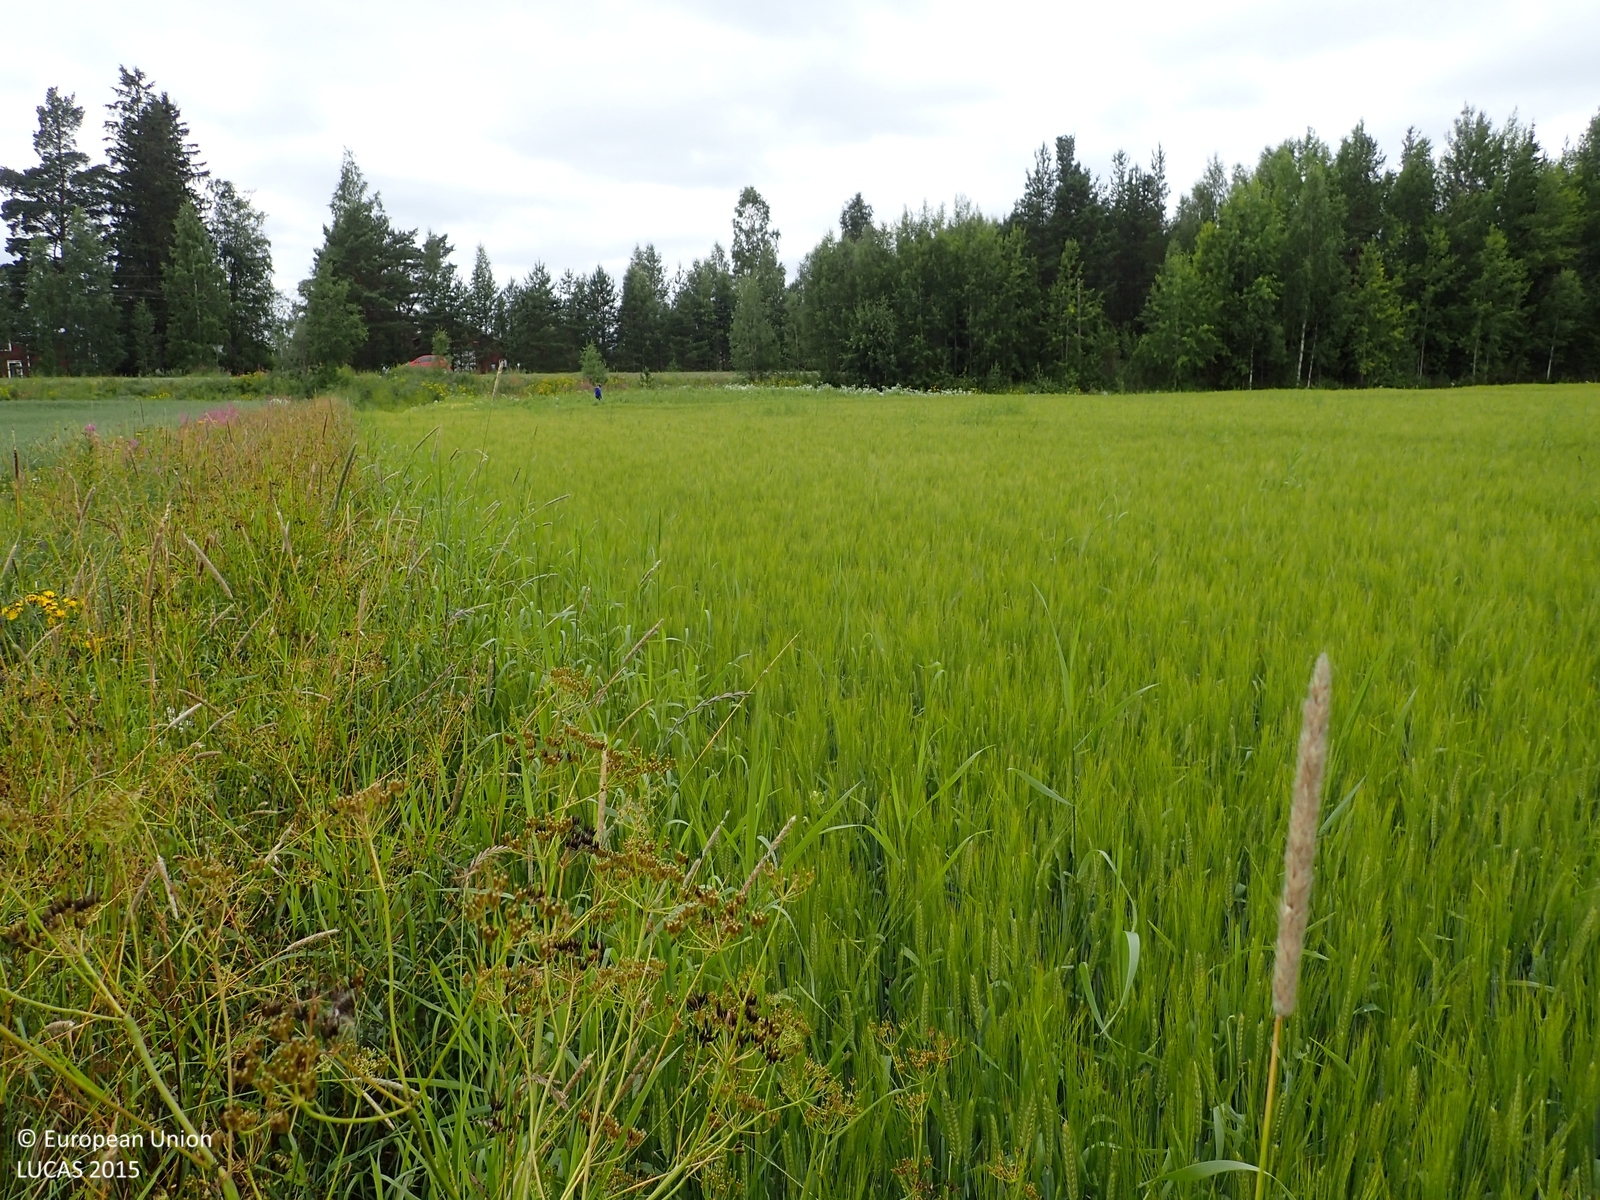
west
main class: Cropland
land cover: Barley
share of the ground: > 75 %
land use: Agriculture (excluding fallow land and kitchen gardens)
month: August
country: FI
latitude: 62.8753
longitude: 22.0591
